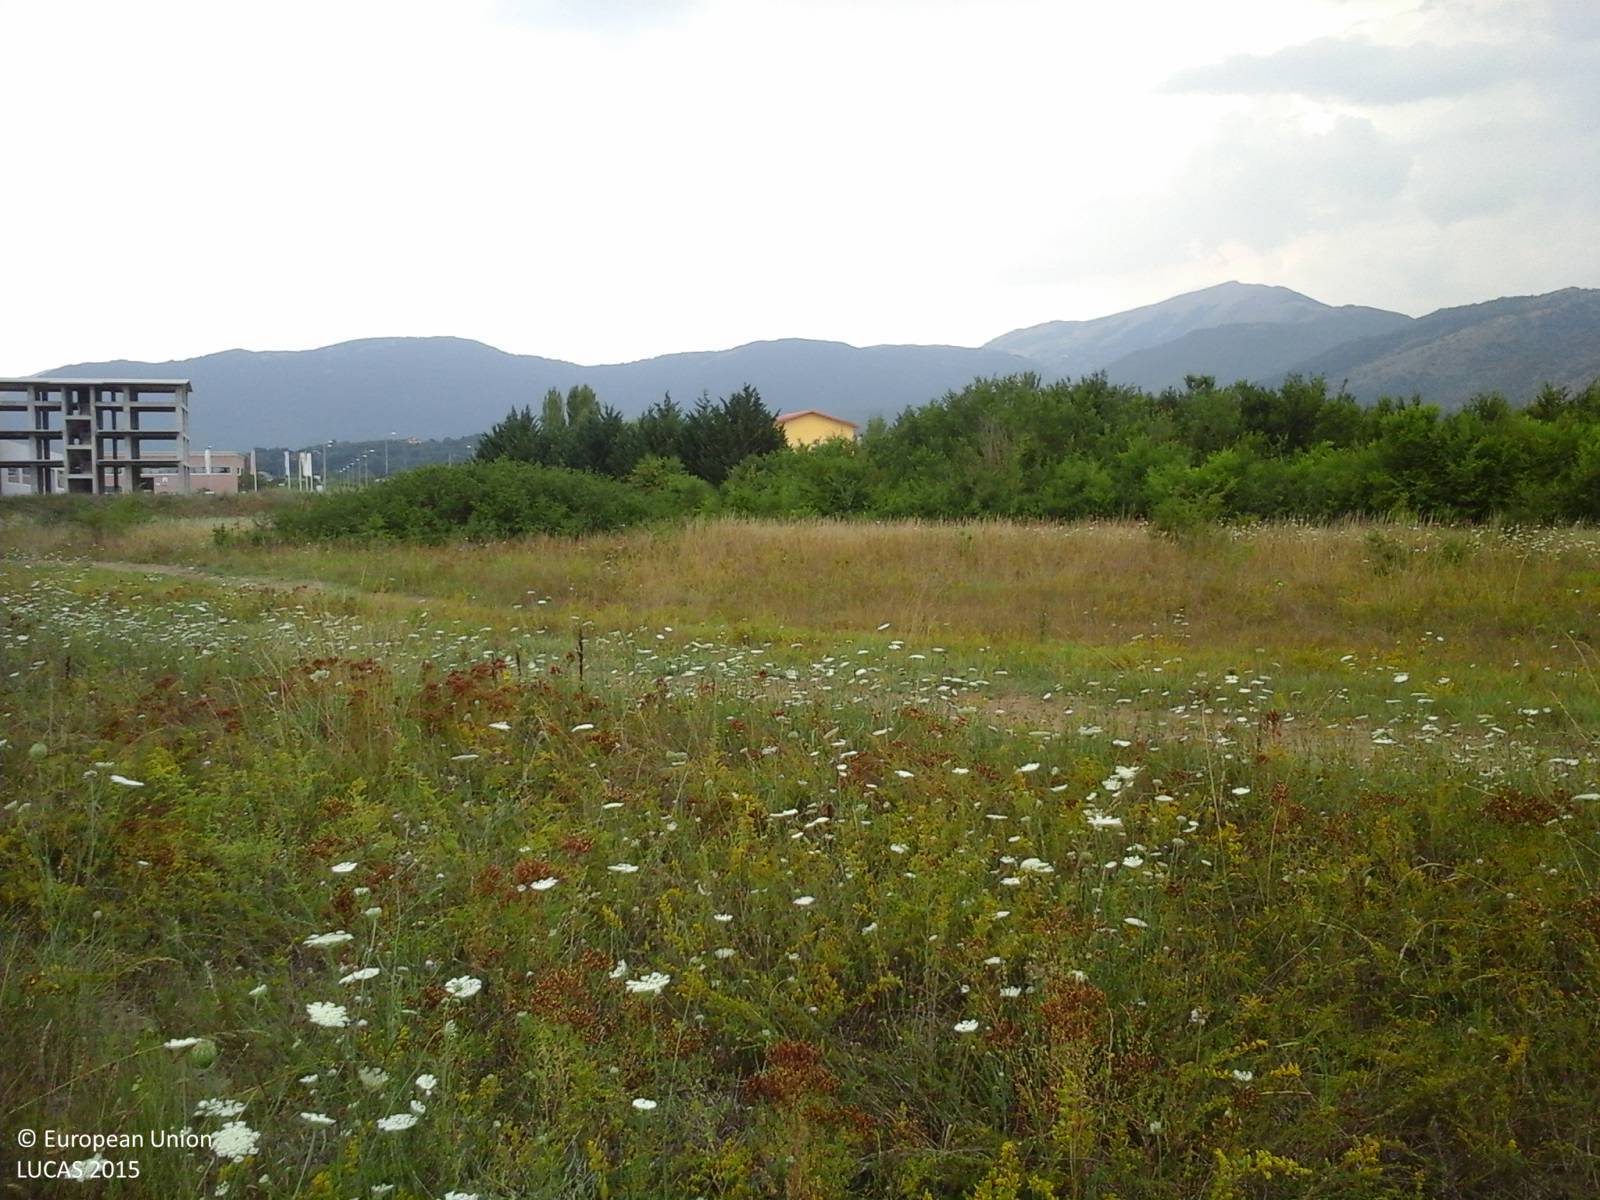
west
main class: Grassland
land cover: Spontaneously vegetated surfaces
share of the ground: > 75 %
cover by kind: herbaceous plants 95 %, shrubs 5 %
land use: Abandoned areas
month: July
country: IT
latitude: 42.3651
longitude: 13.3042
